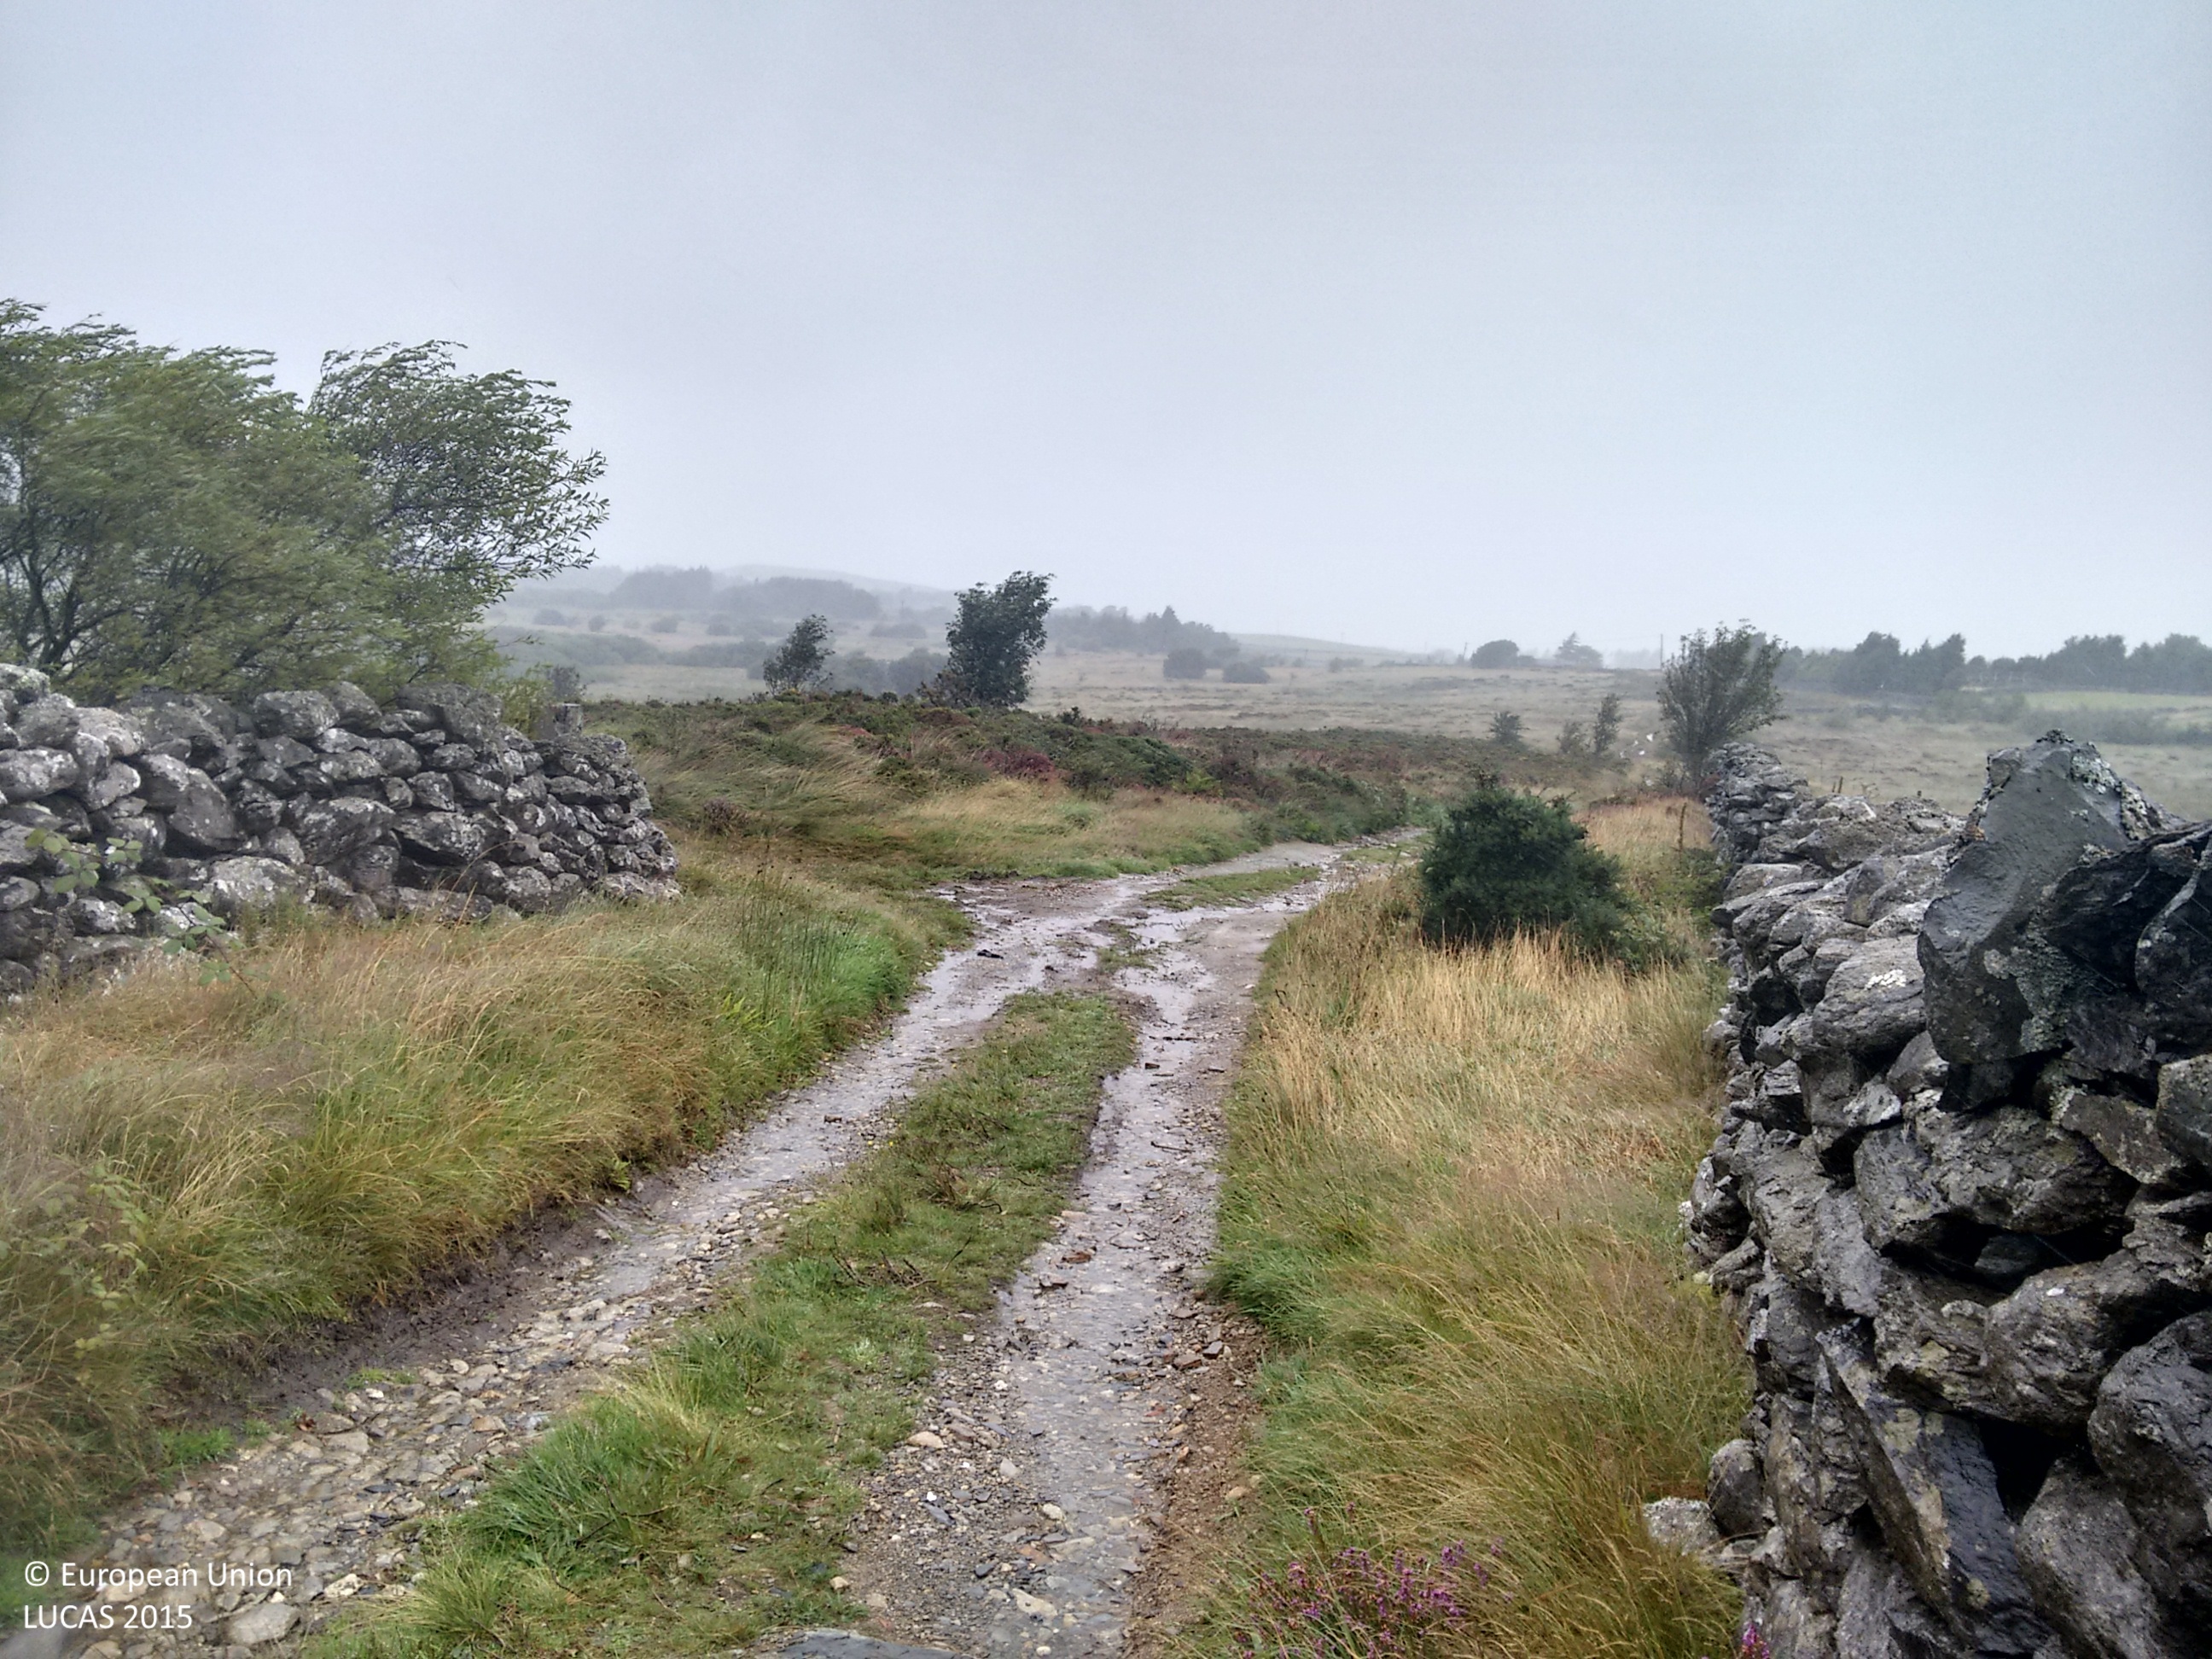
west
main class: Grassland
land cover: Grassland without tree/shrub cover
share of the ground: > 75 %
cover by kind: herbaceous plants 100 %
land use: Agriculture (excluding fallow land and kitchen gardens)
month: August
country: GB
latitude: 53.0284
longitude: -4.2495
